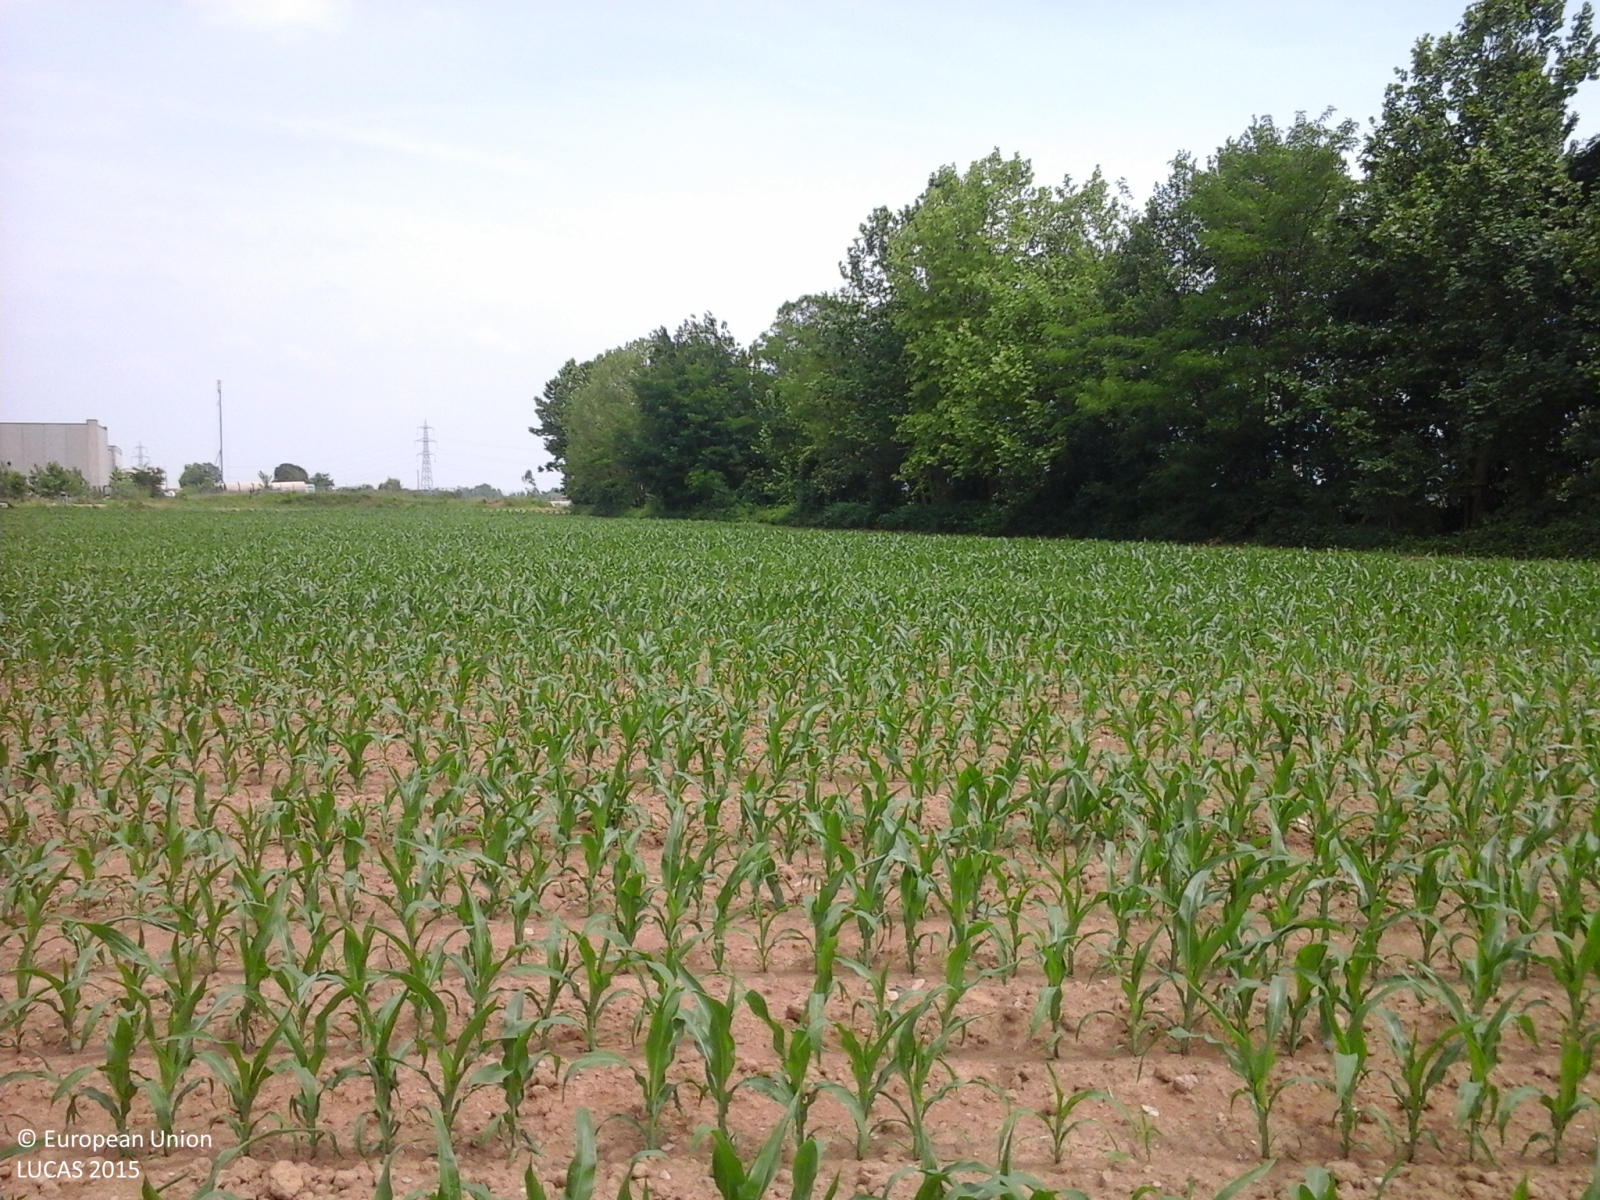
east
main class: Cropland
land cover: Maize
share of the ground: < 10 %
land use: Agriculture (excluding fallow land and kitchen gardens)
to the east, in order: Maize; Managed hedges; Ditches and canals; Grass margins; Ditches and canals; Temporary grasslands
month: May
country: IT
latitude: 45.5578
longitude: 9.6291
